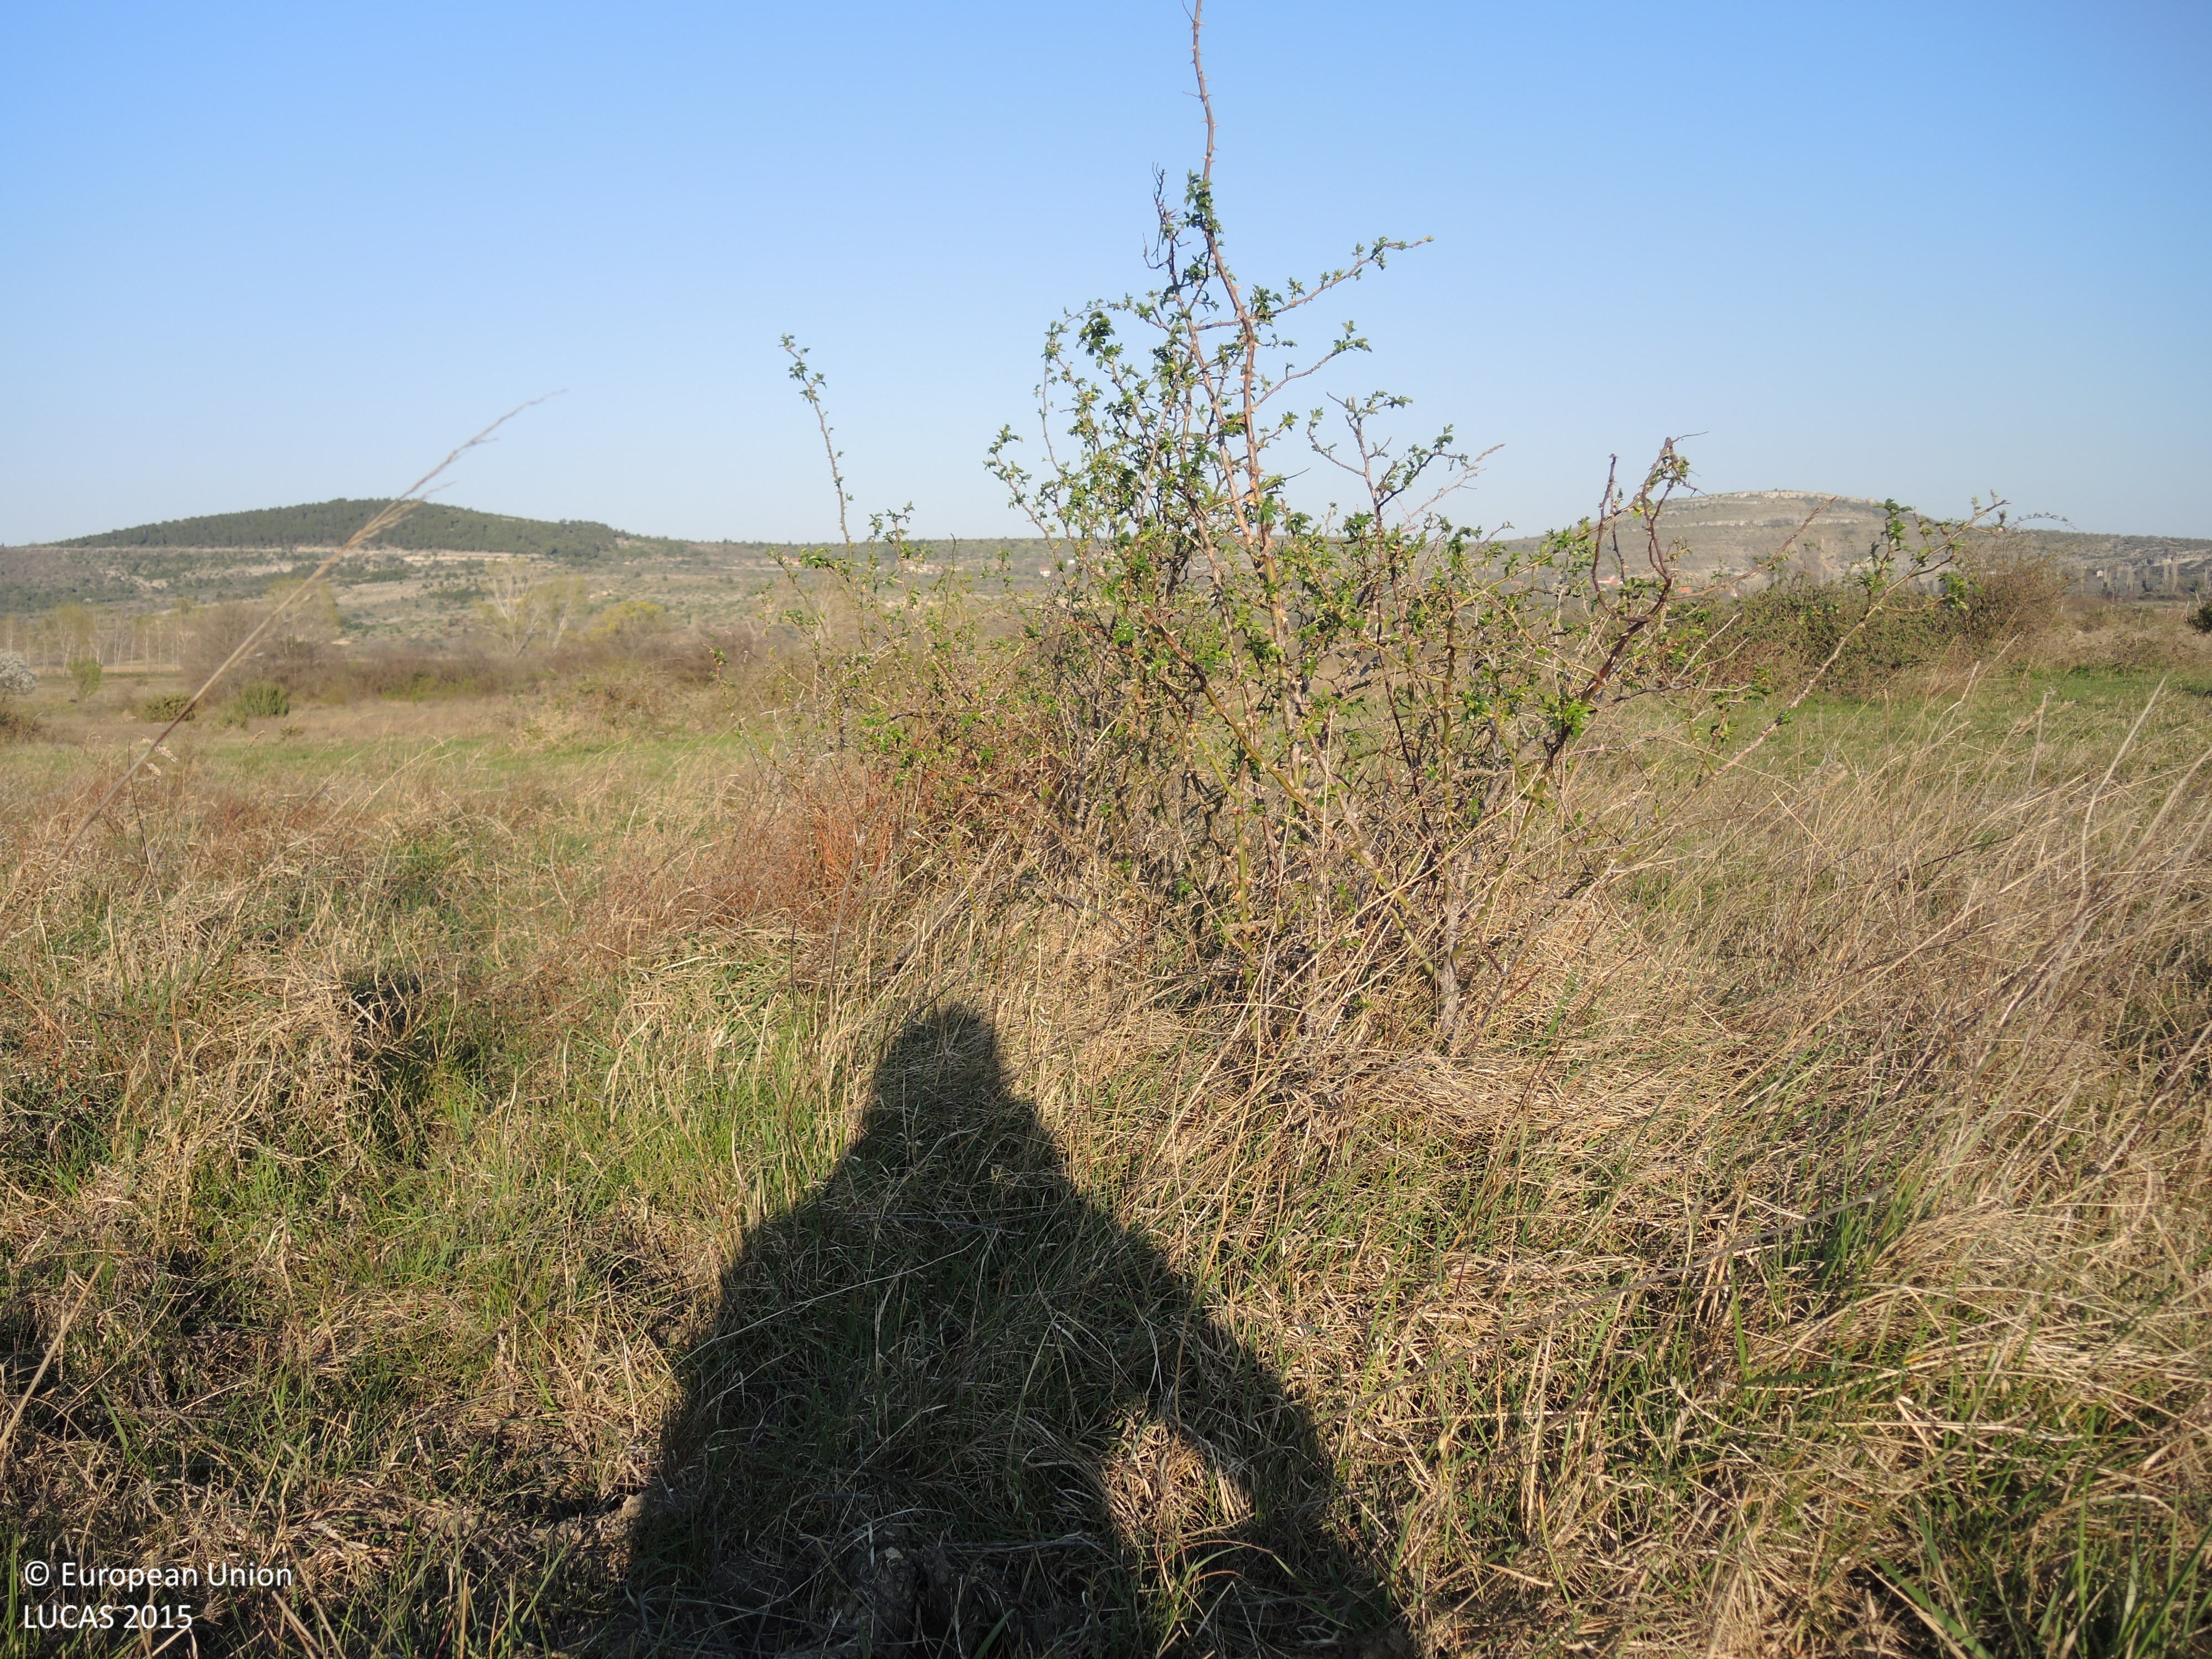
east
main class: Grassland
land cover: Grassland with sparse tree/shrub cover
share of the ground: > 75 %
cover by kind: herbaceous plants 80 %, shrubs 10 %, broadleaved forest trees 5 %, unconsolidated bare surface 5 %
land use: Abandoned areas
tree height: < 5 m
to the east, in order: Grassland with sparse tree/shrub cover; Grassland without tree/shrub cover; Shrubland with sparse tree cover; Dry stone walls; Grass margins; Fences; Clovers; Vineyards; Grassland without tree/shrub cover; Tracks; Grassland without tree/shrub cover; Fences; Olive groves; Grass margins; Fences; Spontaneously vegetated surfaces
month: April
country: HR
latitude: 43.9347
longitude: 15.8092
